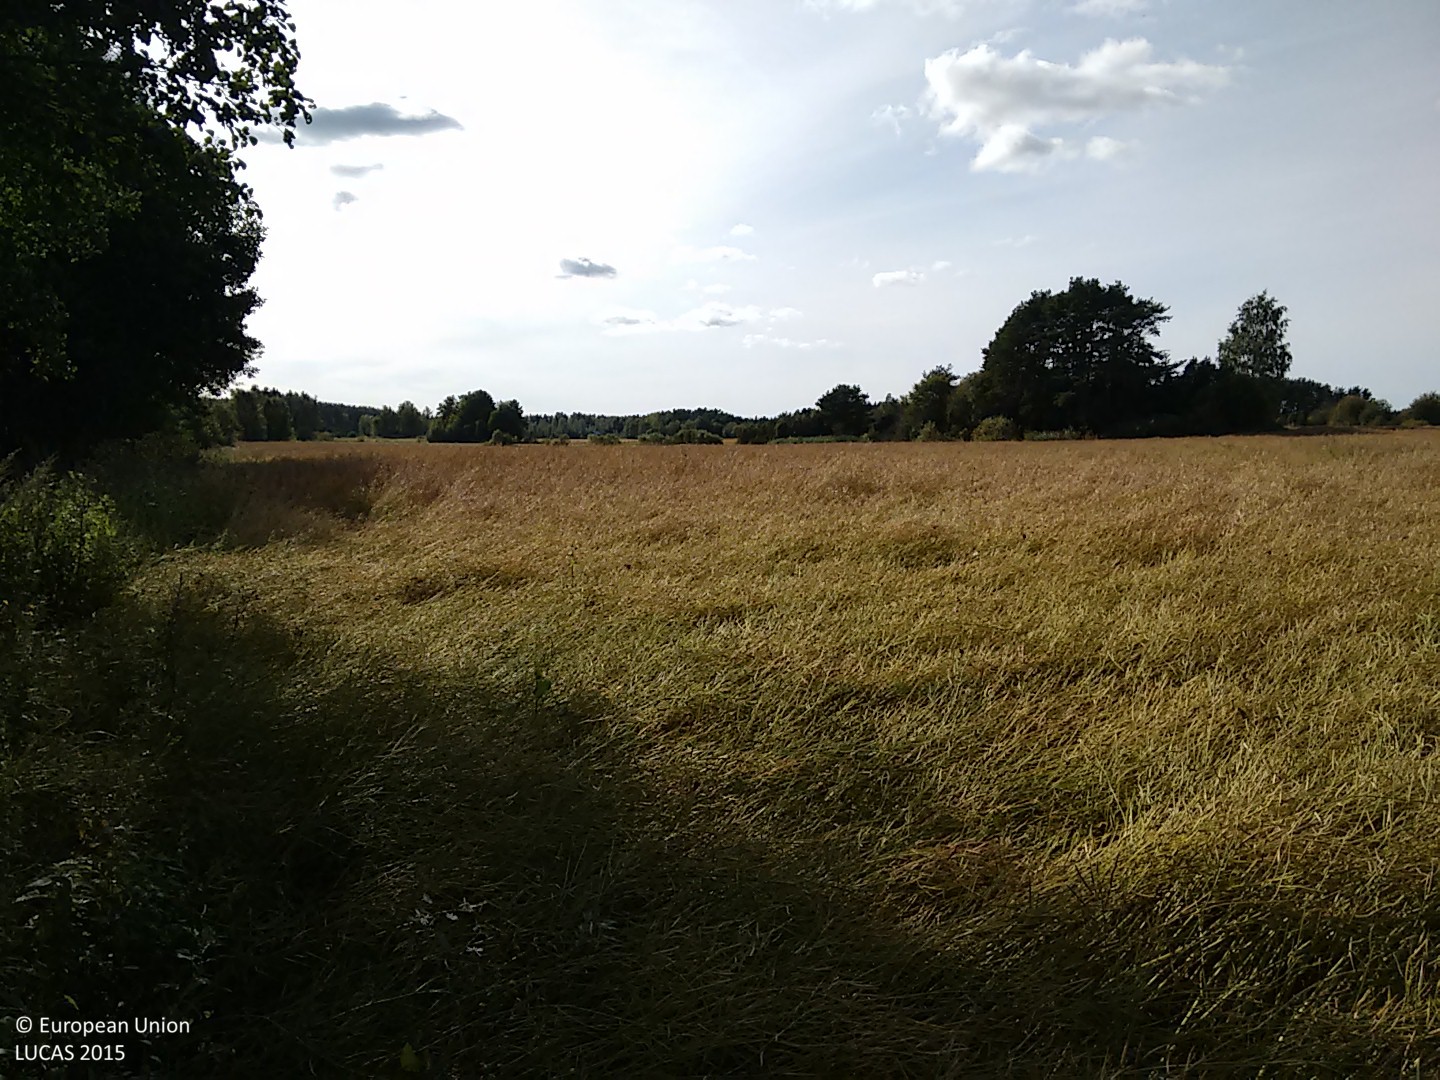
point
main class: Cropland
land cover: Rape and turnip rape
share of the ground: > 75 %
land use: Agriculture (excluding fallow land and kitchen gardens)
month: September
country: FI
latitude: 60.8048
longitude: 21.6906
